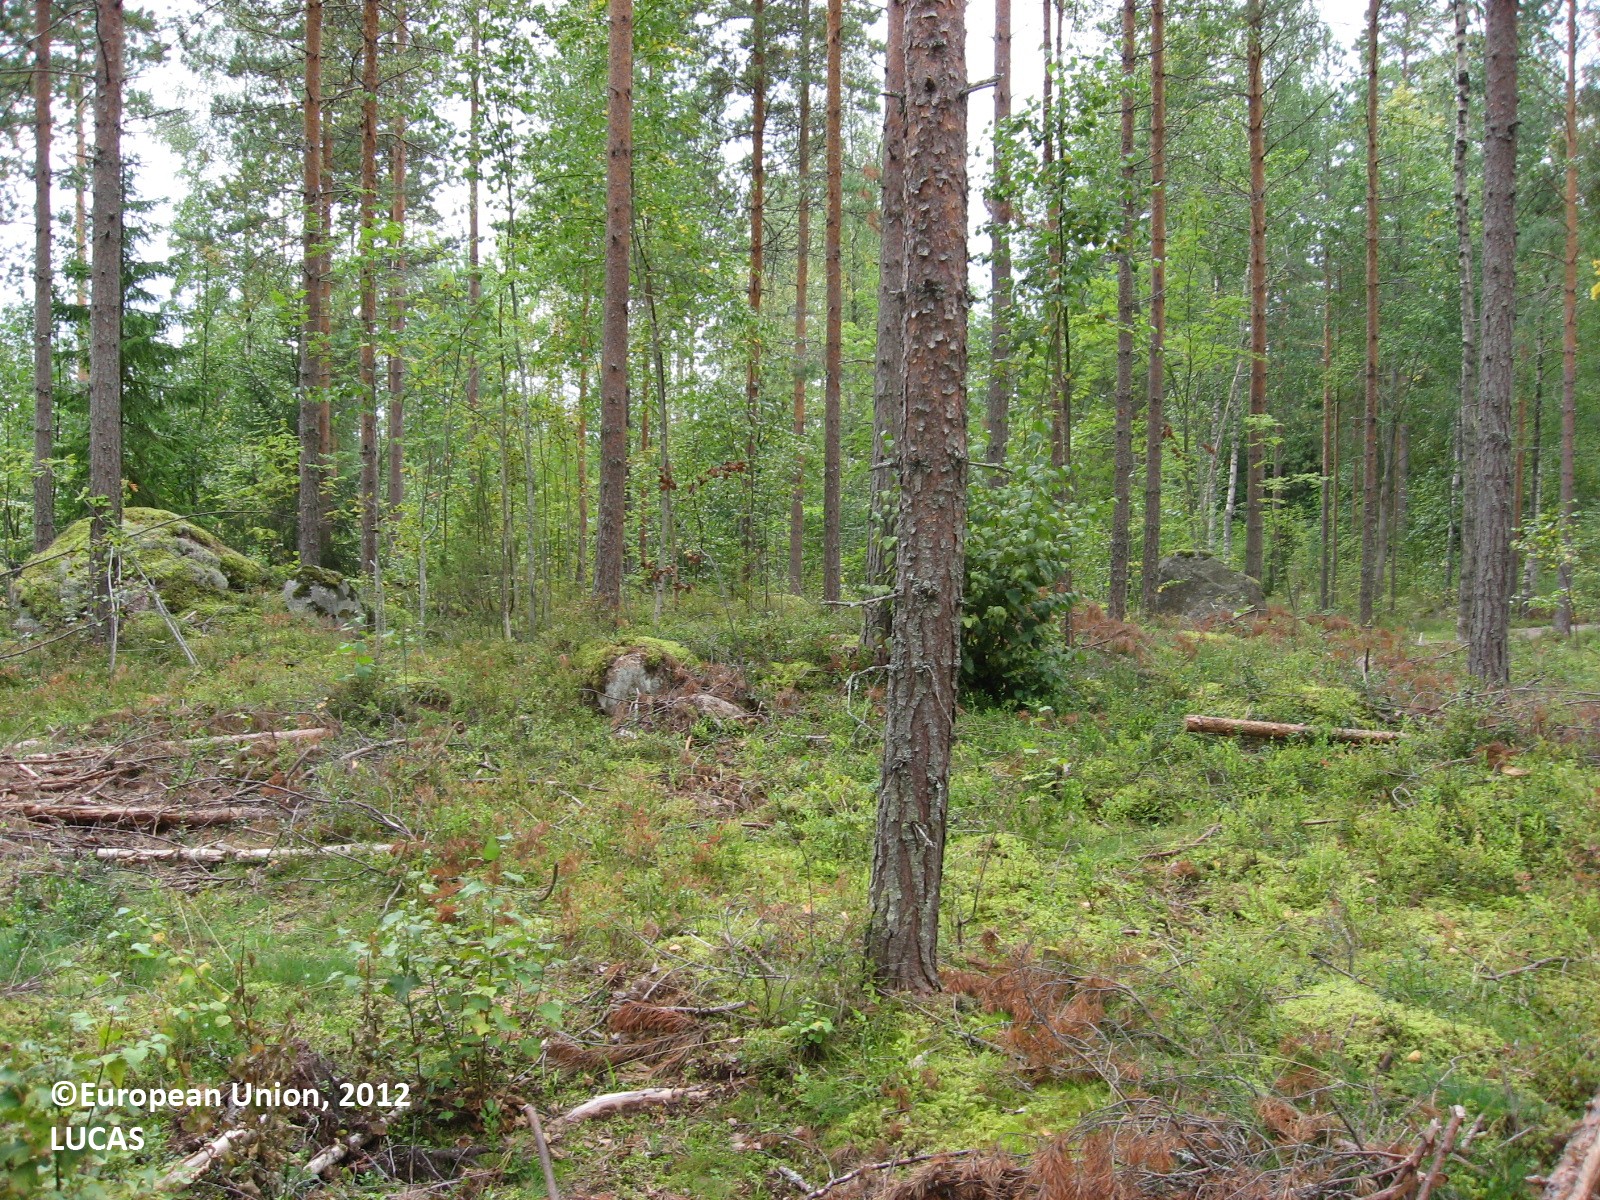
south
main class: Woodland
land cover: Pine dominated mixed woodland
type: boreal forest
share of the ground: 50 - 75 %
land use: Forestry
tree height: > 5 m
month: September
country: FI
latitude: 61.1268
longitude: 26.4302
